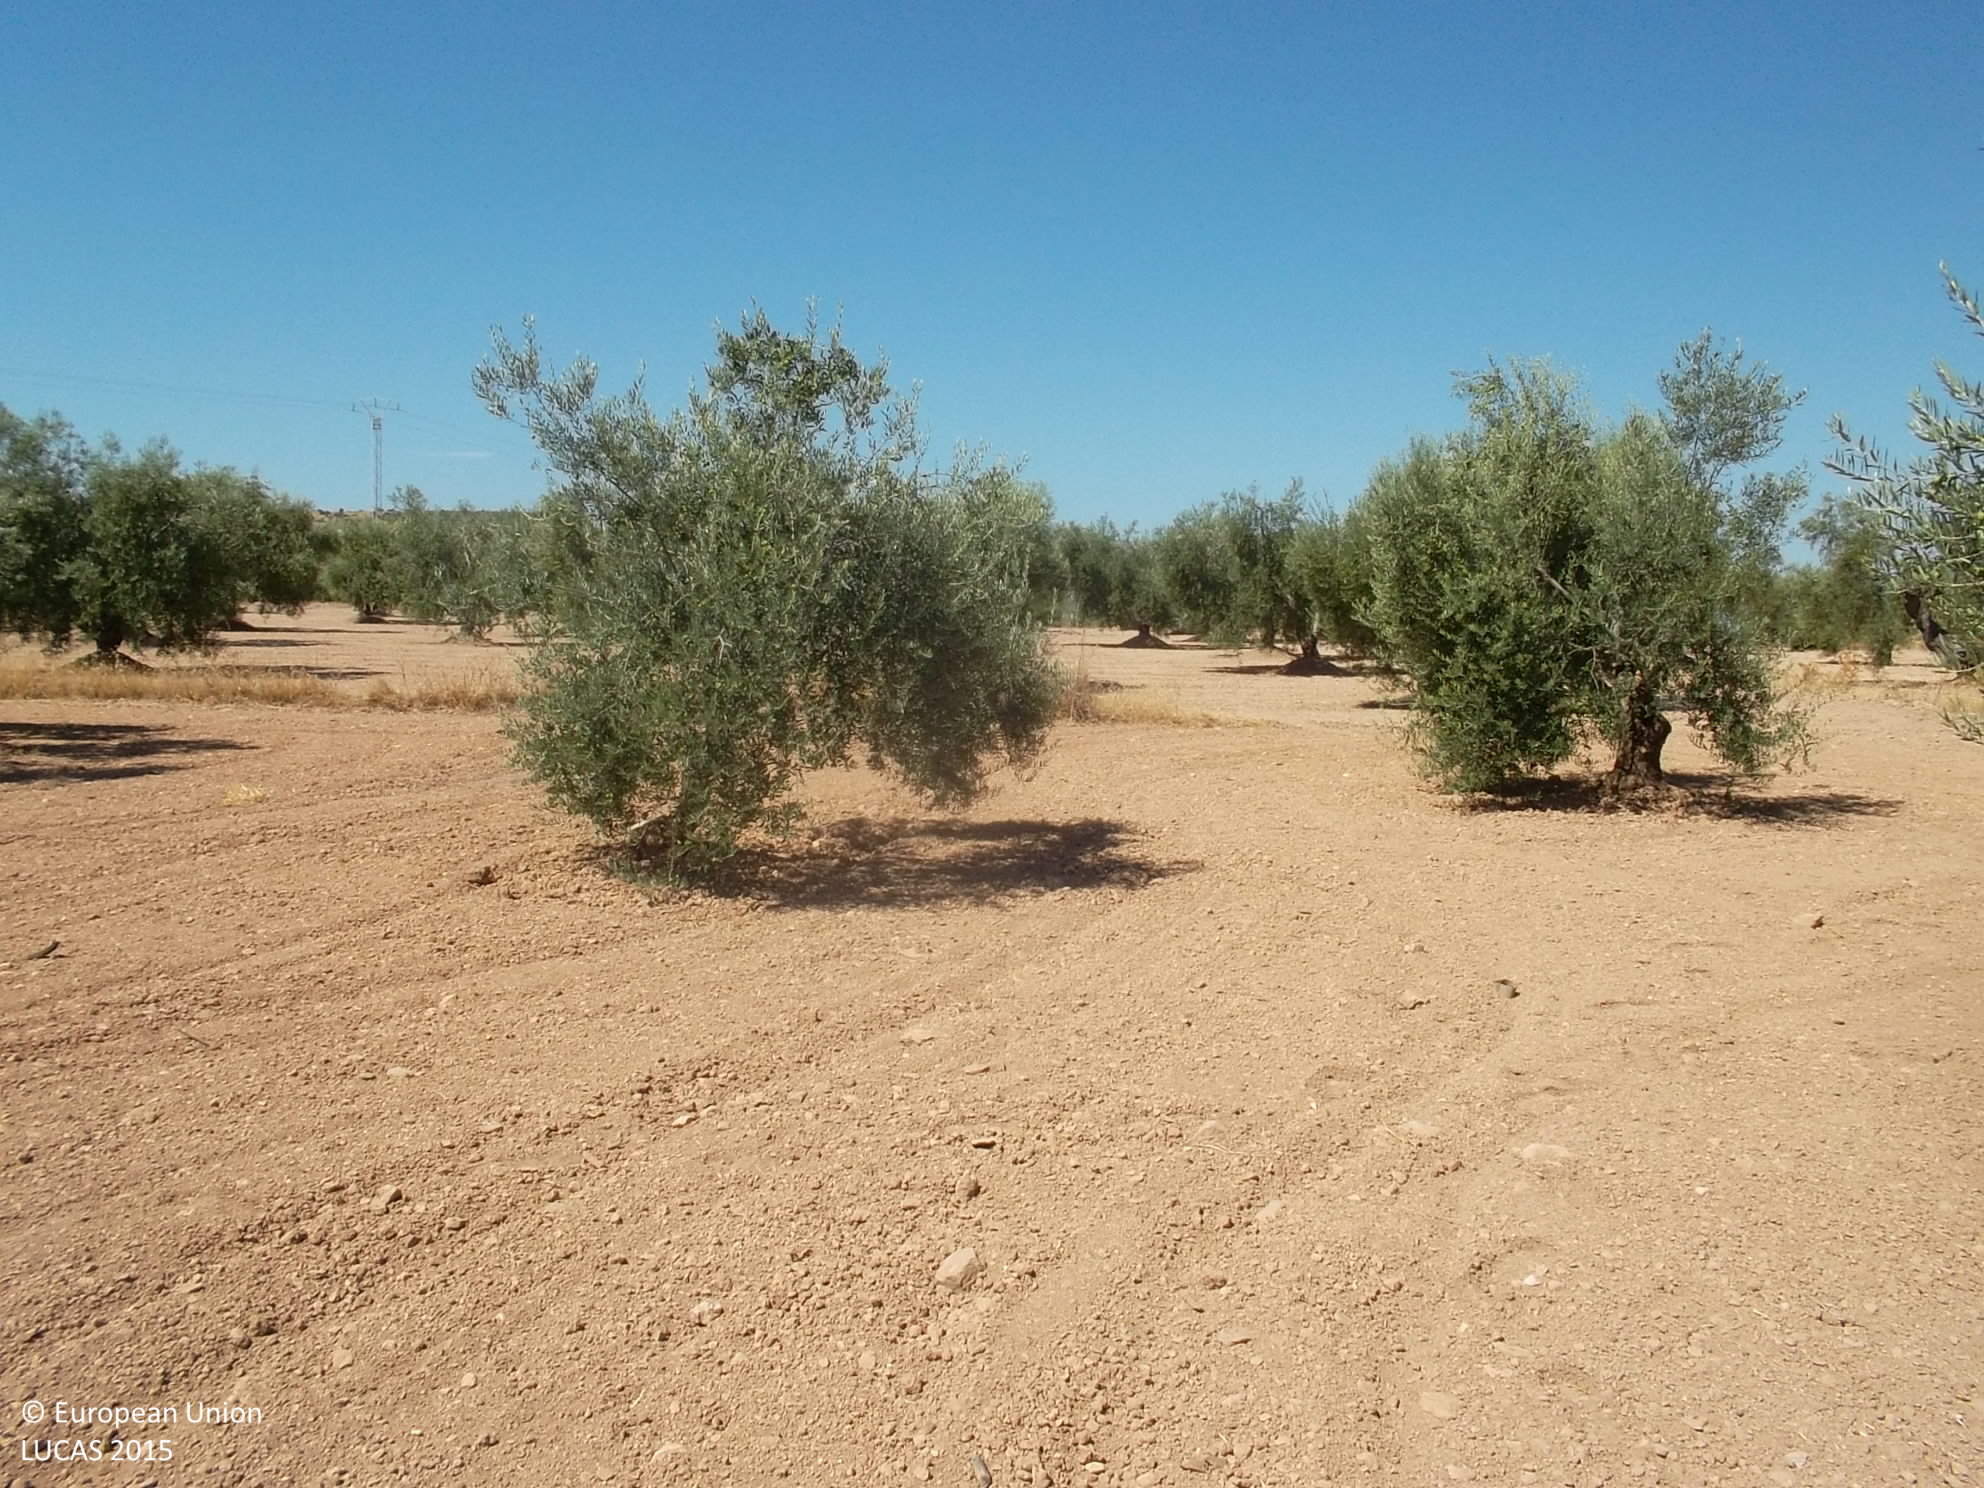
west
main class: Cropland
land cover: Olive groves
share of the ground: 25 - 50 %
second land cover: Other bare soil
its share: > 75 %
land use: Agriculture (excluding fallow land and kitchen gardens)
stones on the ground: 10 - 25 %
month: August
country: ES
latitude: 38.5270
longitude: -6.3975
